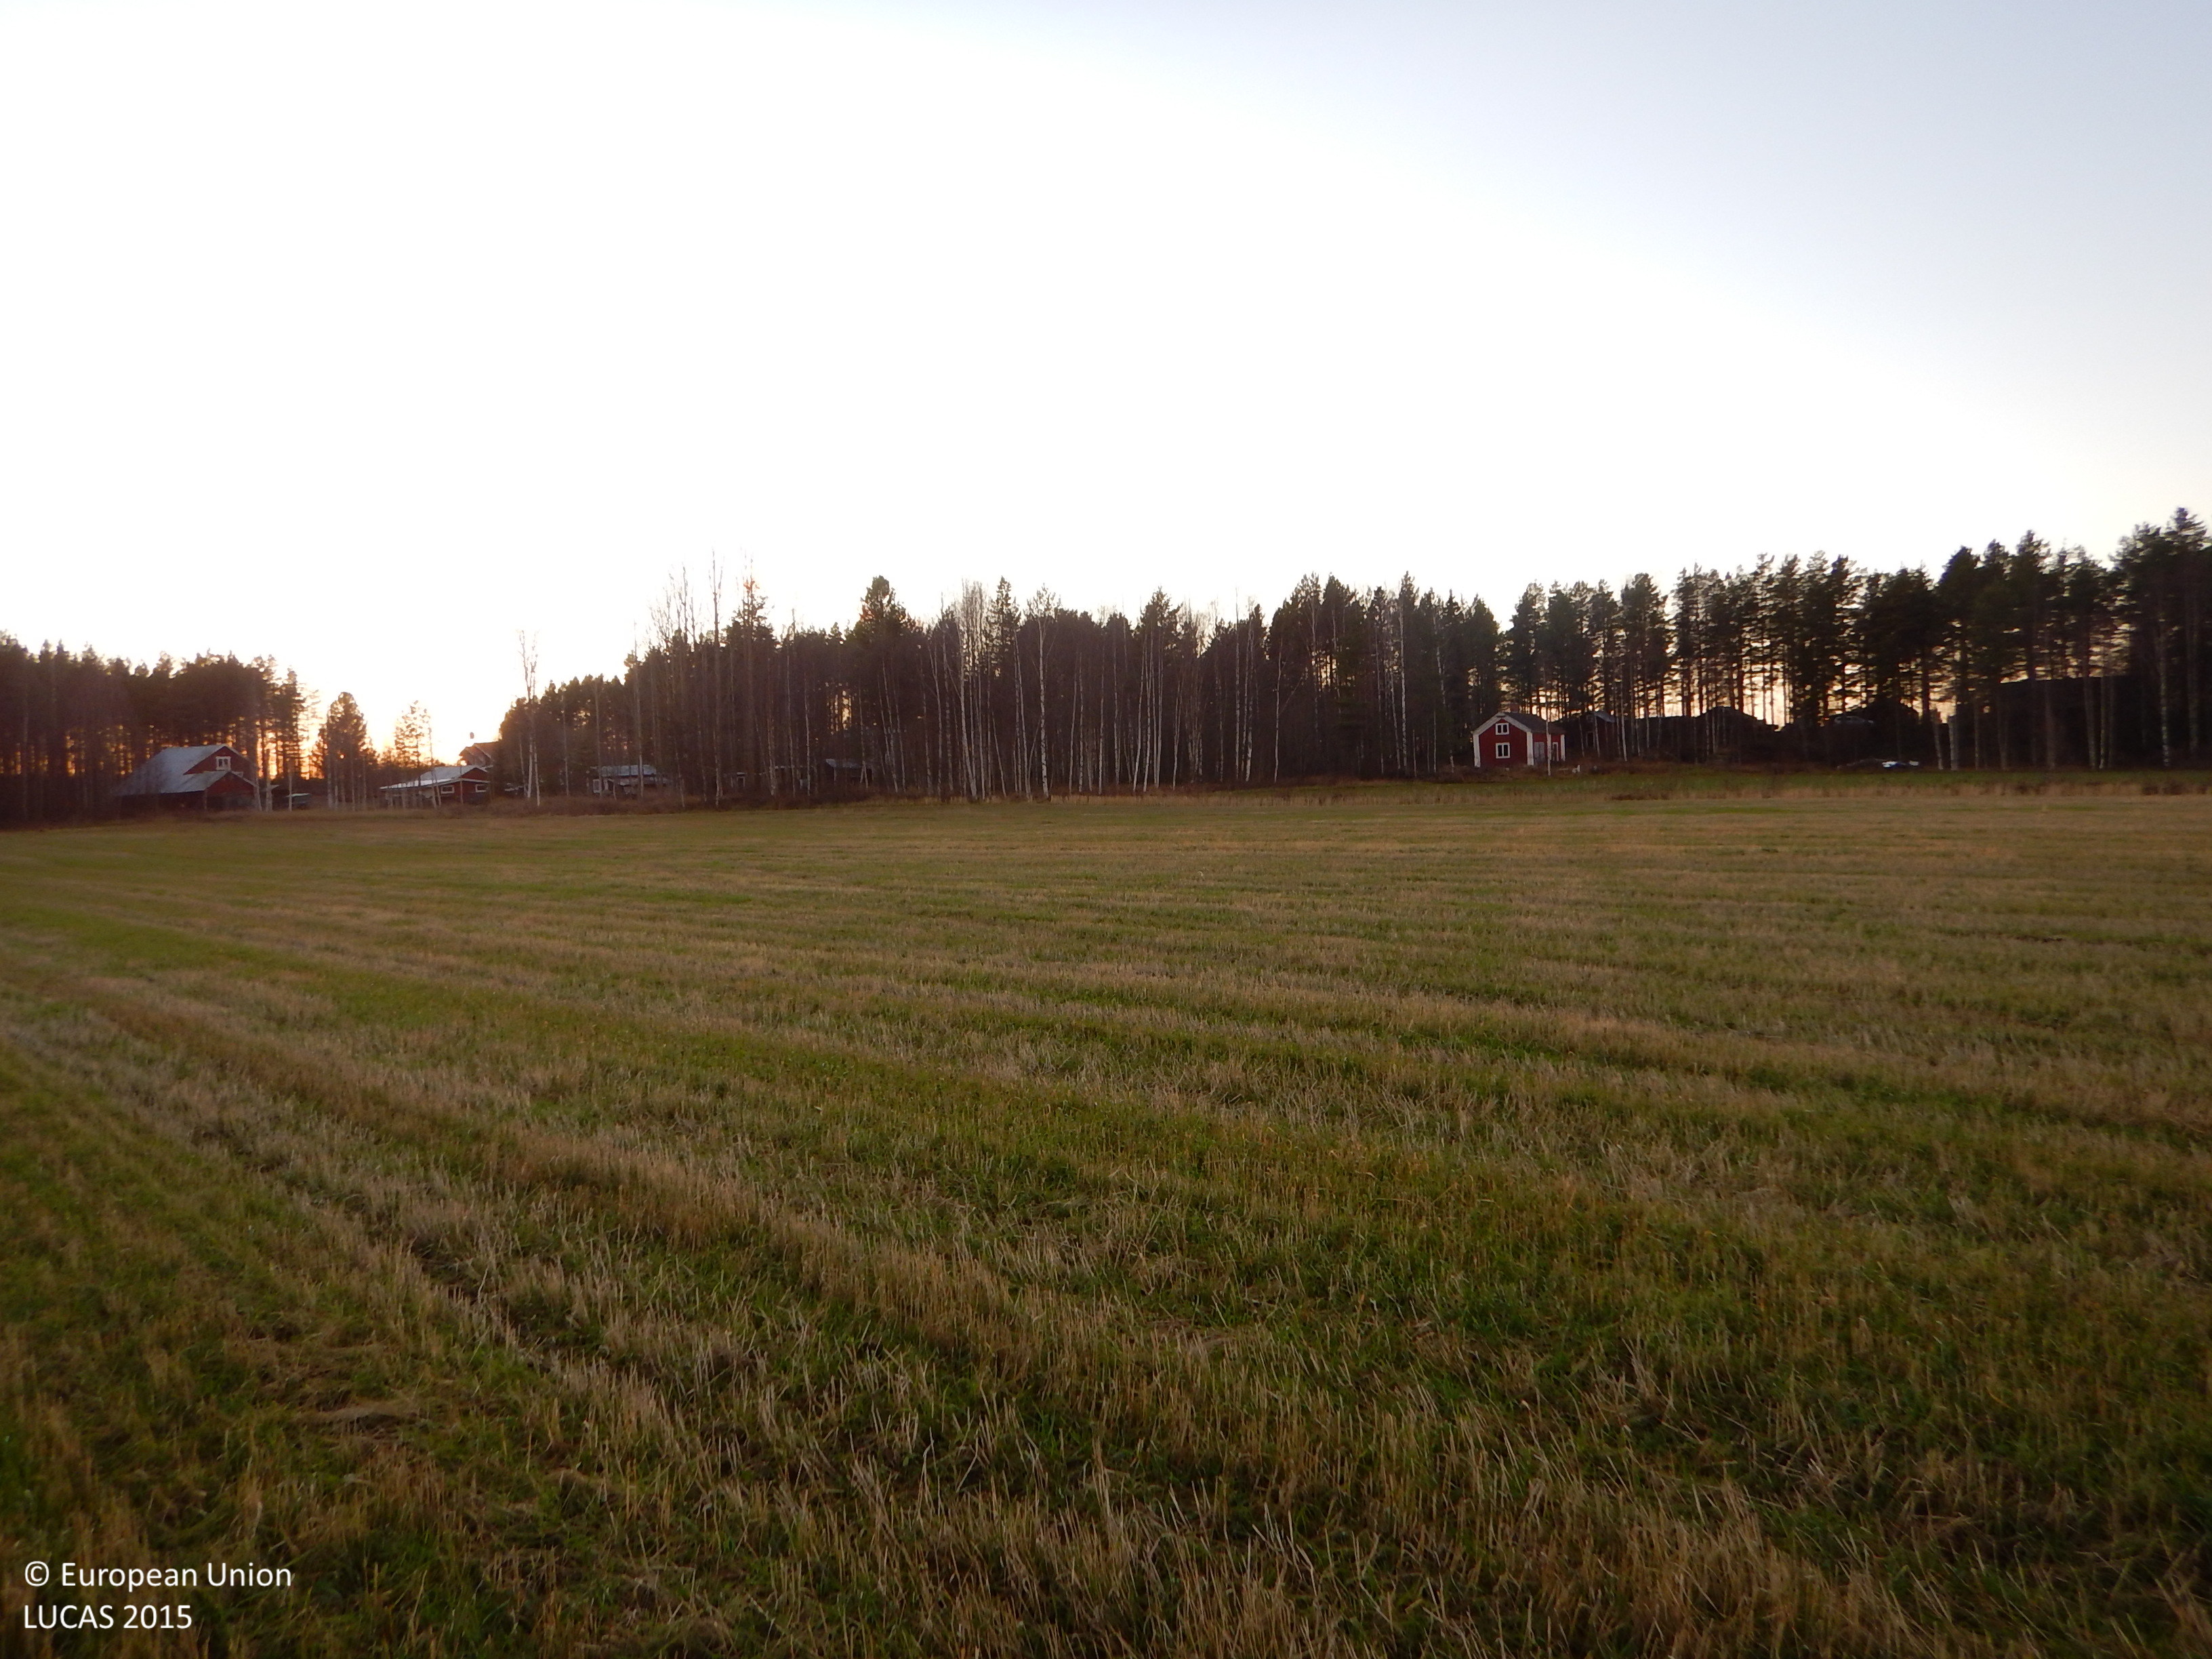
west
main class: Cropland
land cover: Temporary grasslands
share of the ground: > 75 %
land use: Agriculture (excluding fallow land and kitchen gardens)
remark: Harvested field
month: November
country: SE
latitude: 65.3351
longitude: 21.2057
